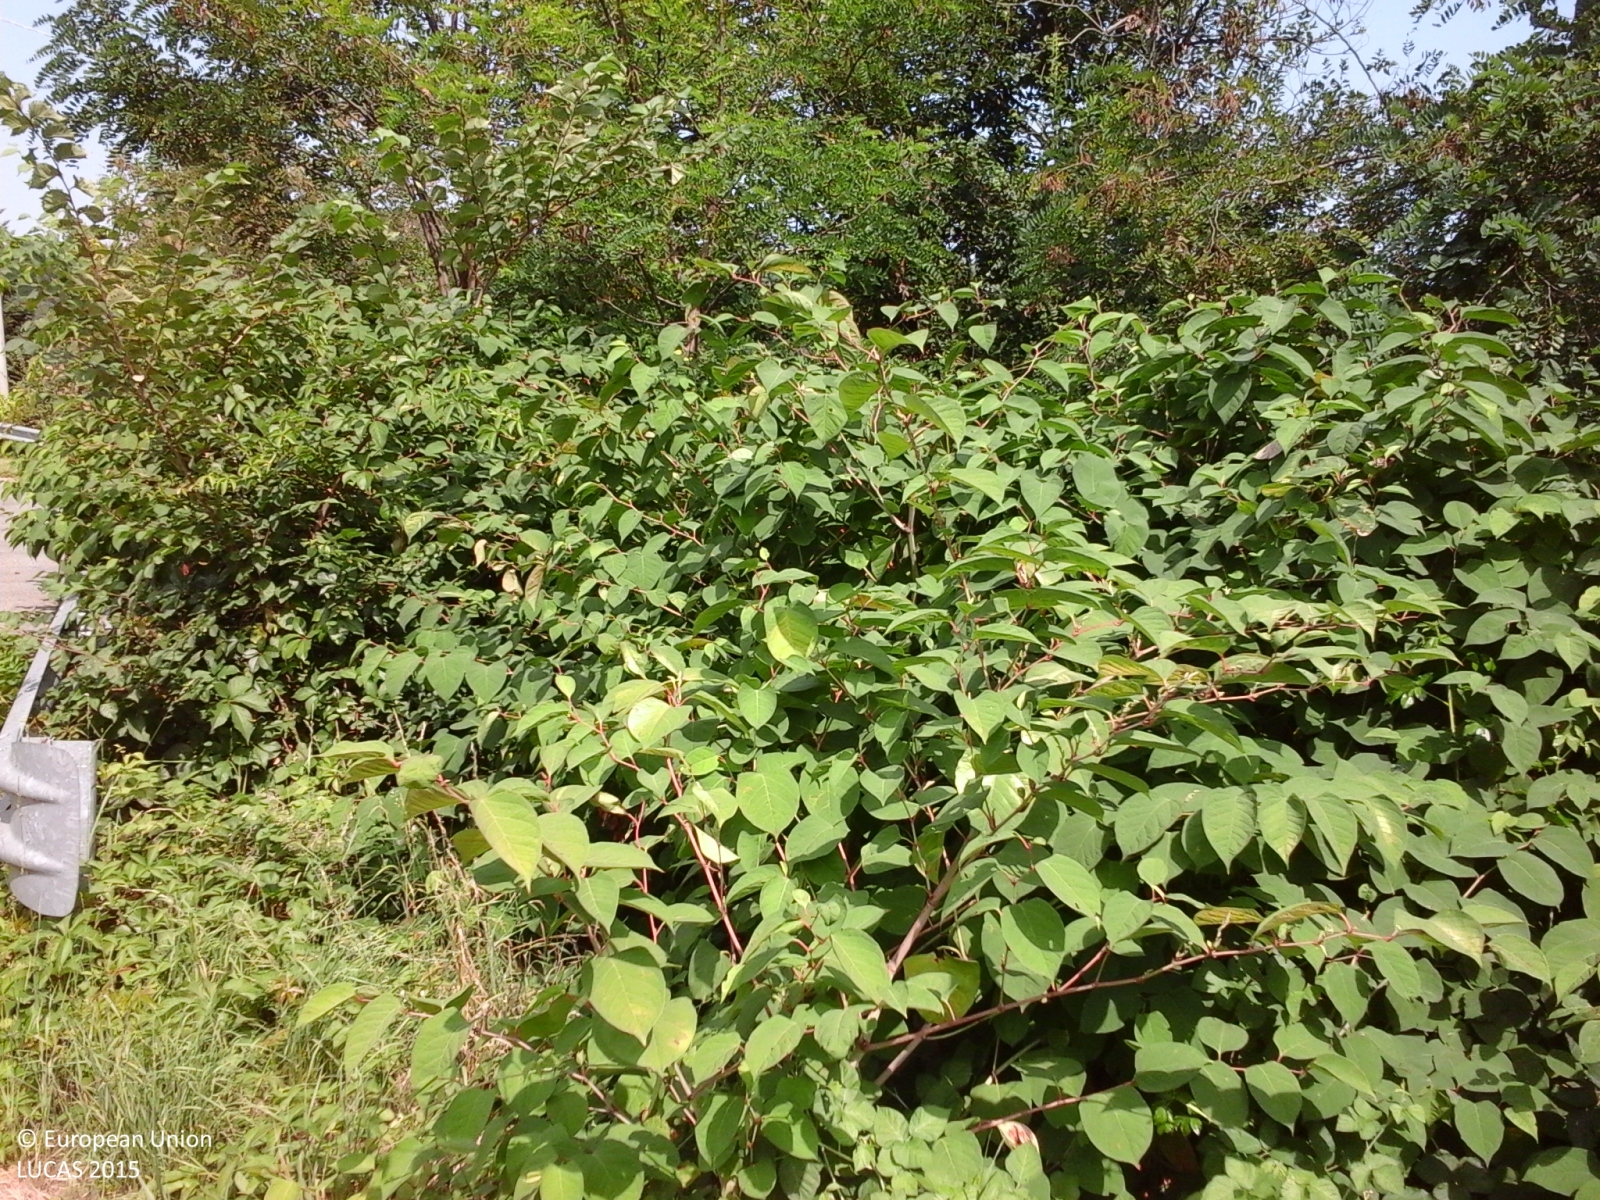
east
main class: Woodland
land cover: Broadleaved woodland
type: thermophilous deciduous forest
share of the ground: > 75 %
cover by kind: broadleaved forest trees 100 %
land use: Semi-natural and natural areas not in use
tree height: > 5 m
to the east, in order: Broadleaved woodland; Electric lines; Broadleaved woodland; Artificial constructions in urban areas; Broadleaved woodland
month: July
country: IT
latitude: 44.9110
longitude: 7.3069
